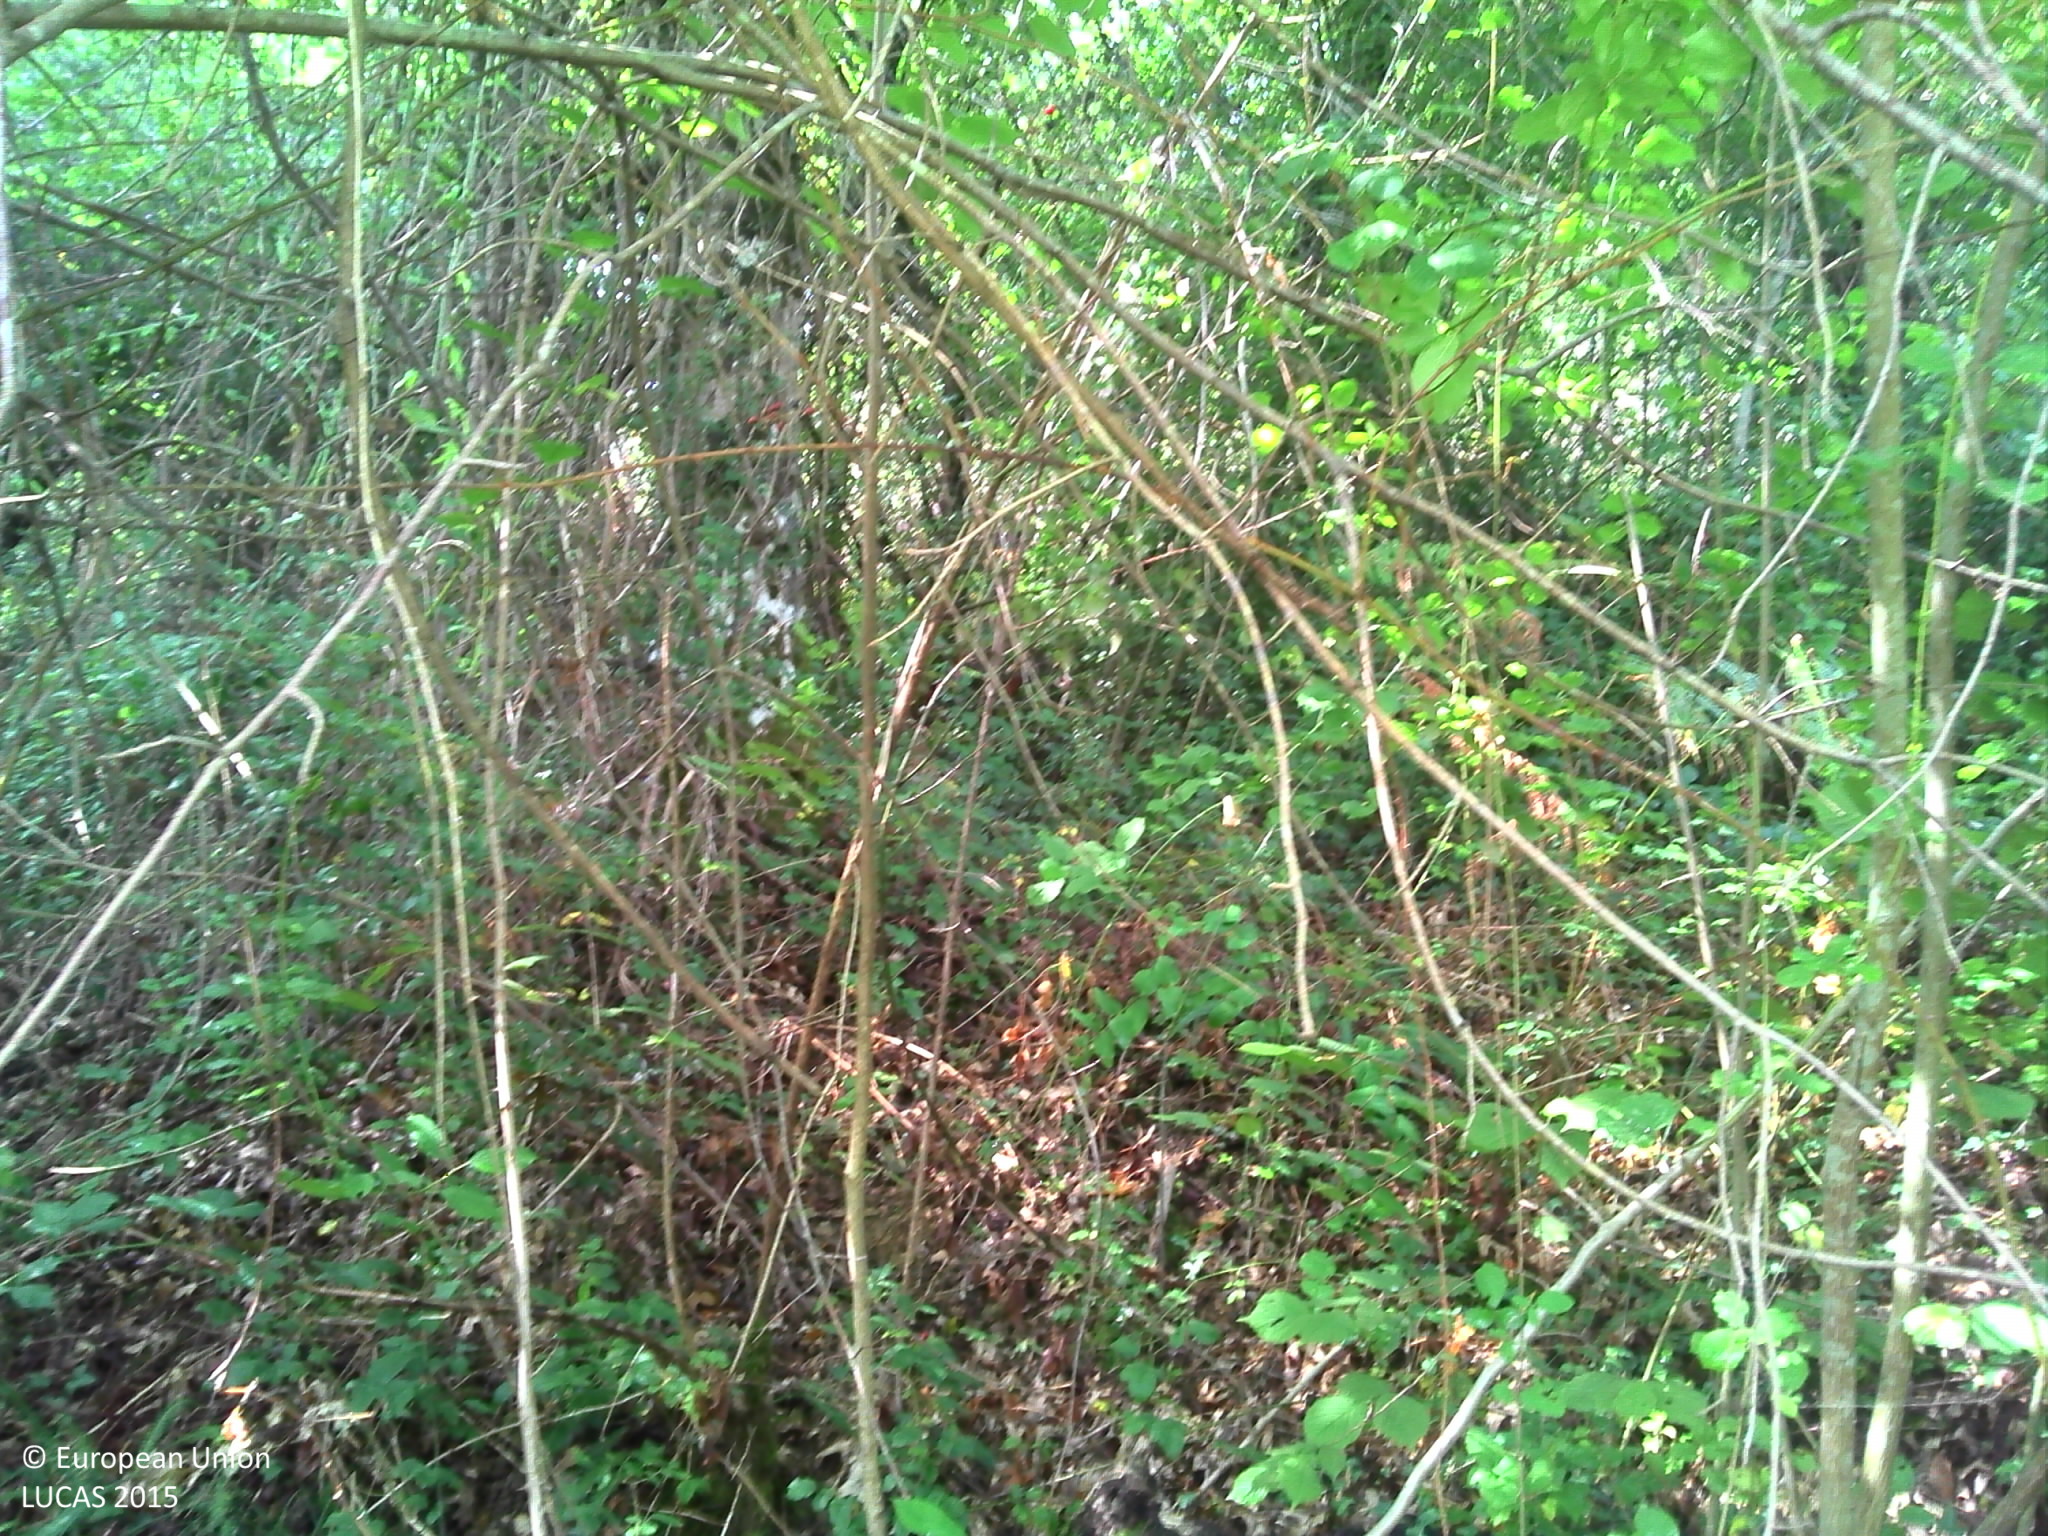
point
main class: Woodland
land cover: Broadleaved woodland
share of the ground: > 75 %
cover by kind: broadleaved forest trees 60 %, shrubs 30 %, herbaceous plants 5 %, lichens and mosses 5 %
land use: Forestry
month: September
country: FR
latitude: 43.1972
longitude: -1.0256
